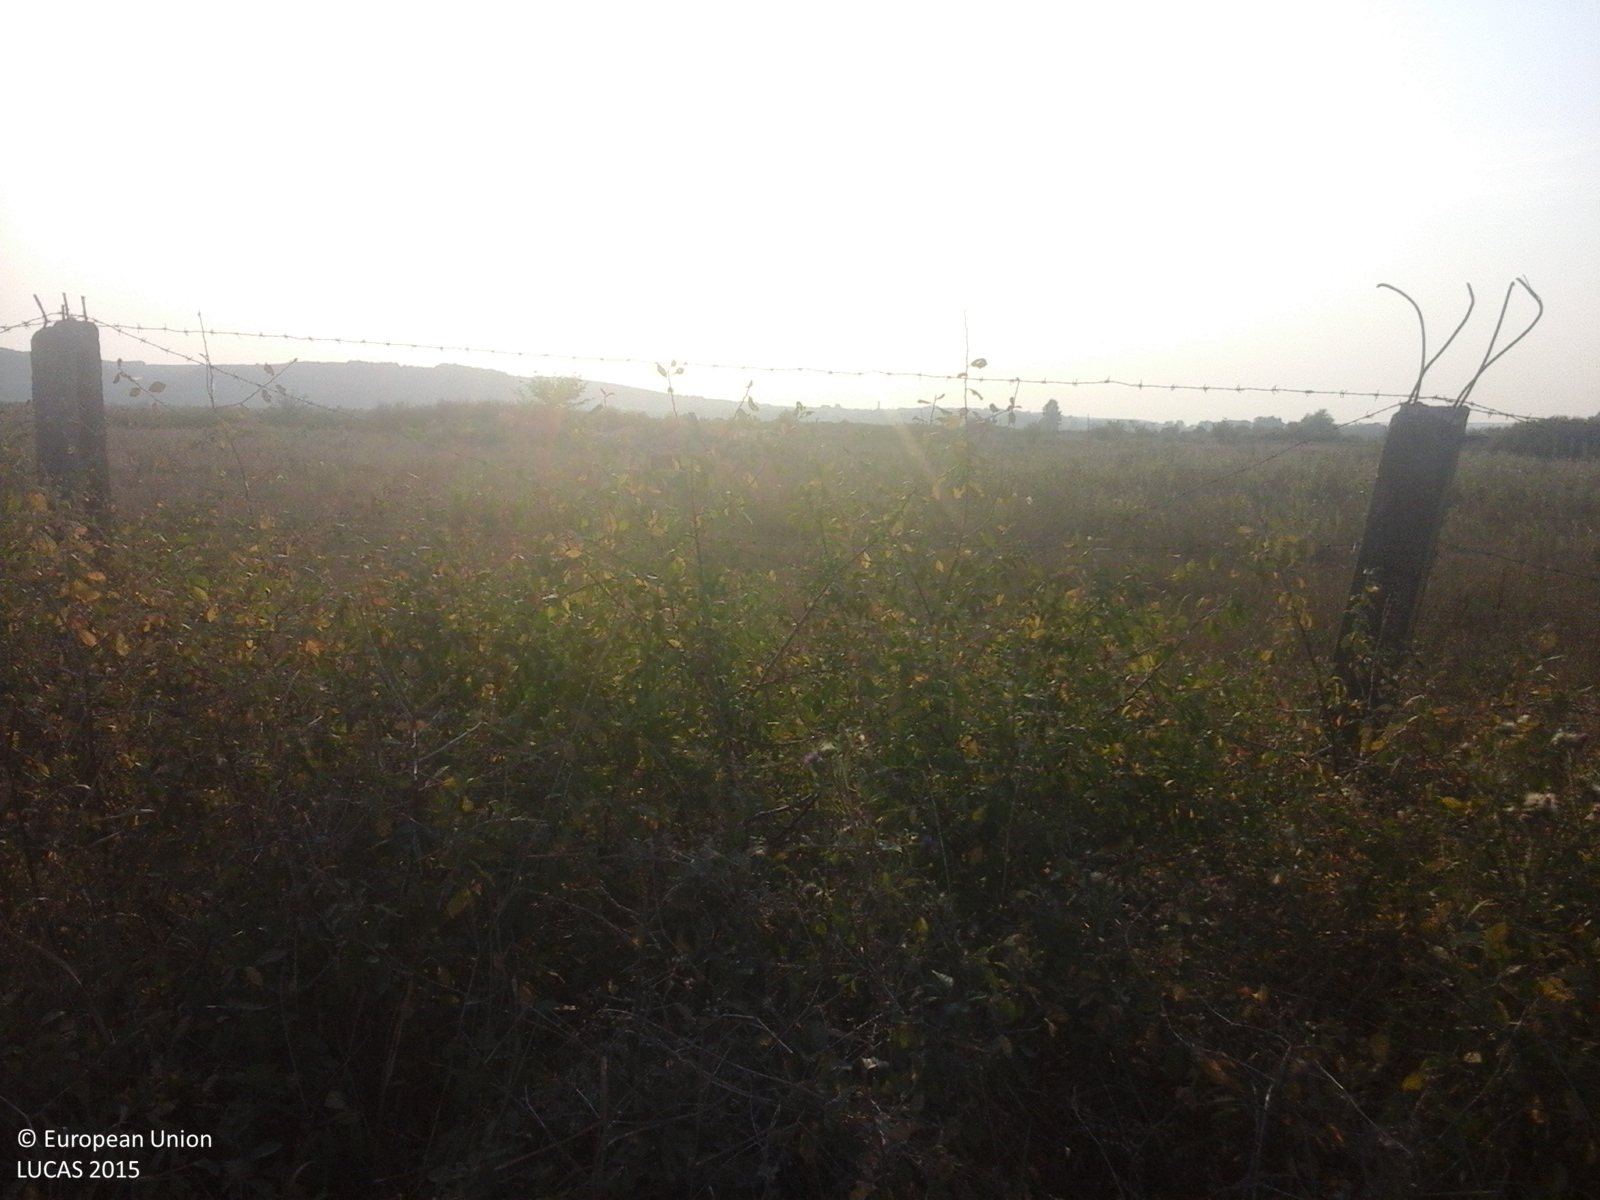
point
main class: Grassland
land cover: Spontaneously vegetated surfaces
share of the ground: > 75 %
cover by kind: herbaceous plants 100 %
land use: Agriculture (excluding fallow land and kitchen gardens)
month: August
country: RO
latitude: 44.3274
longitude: 23.7370
